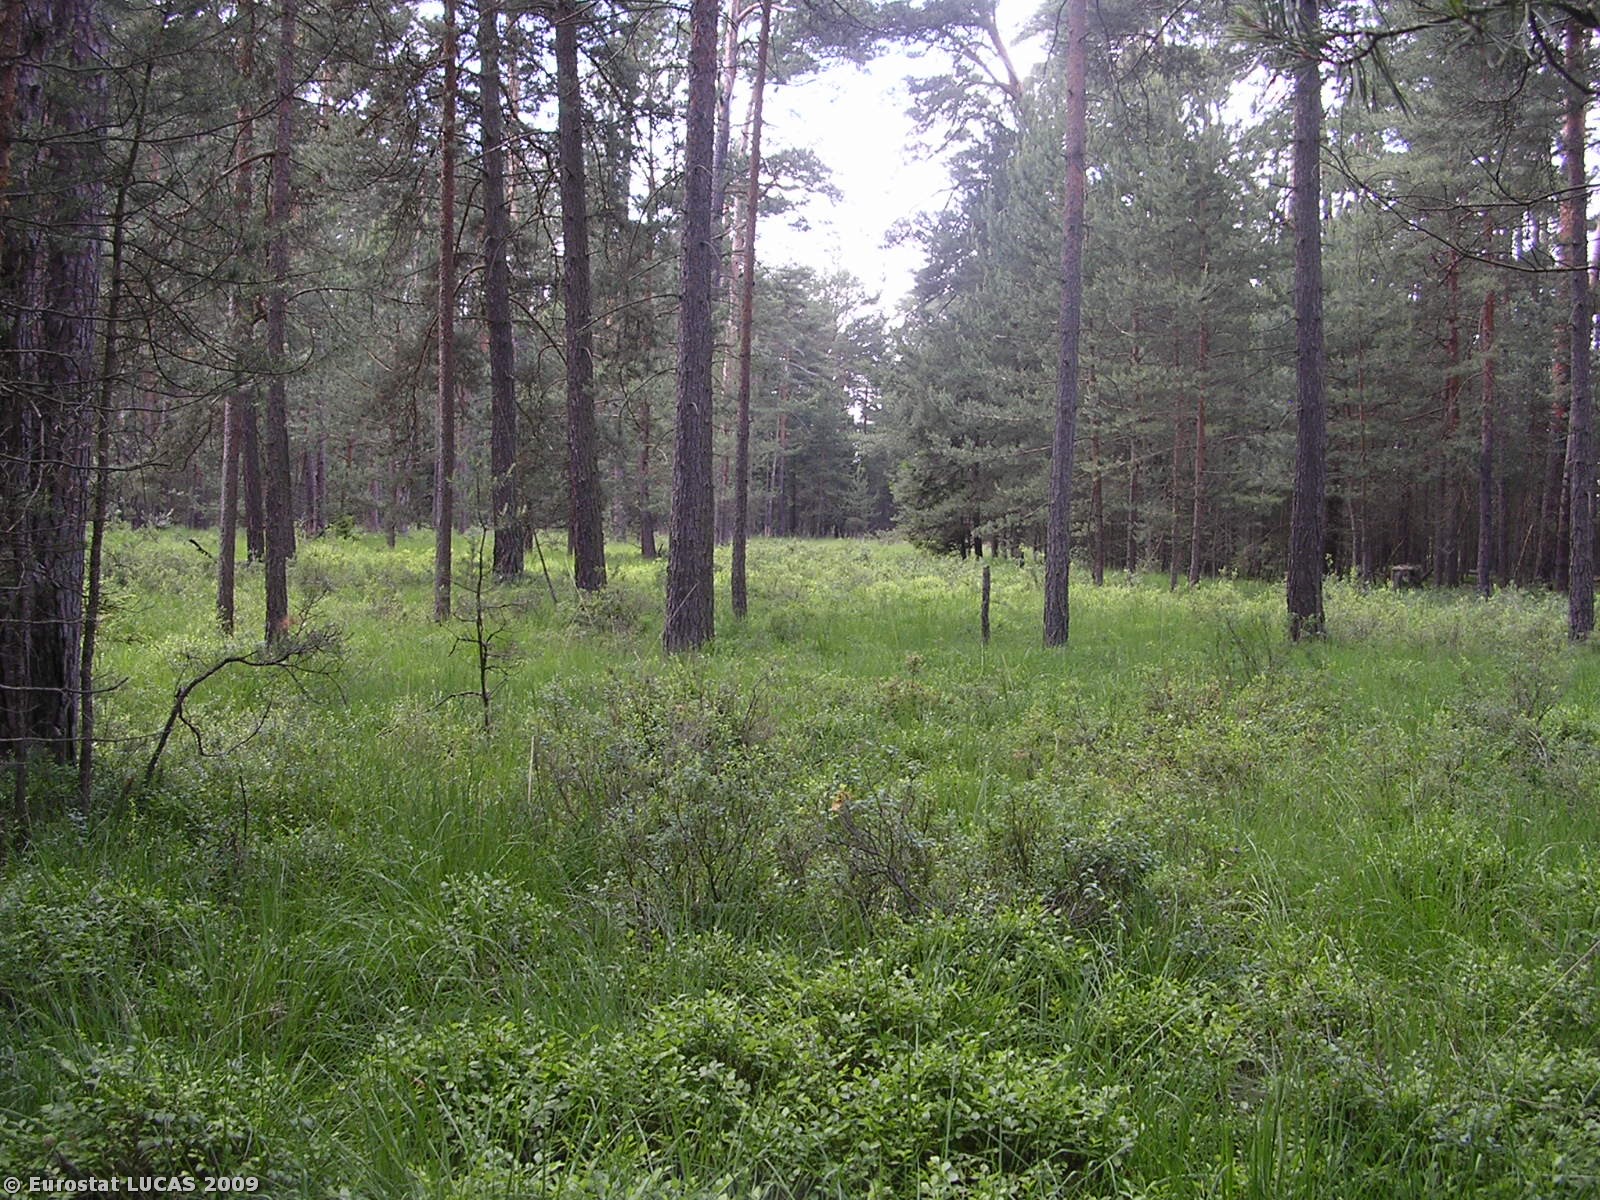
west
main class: Woodland
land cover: Coniferous woodland
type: hemiboreal forest and nemoral coniferous forest and mixed broadleaved-coniferous forest
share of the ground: > 75 %
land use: Nature reserves
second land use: Forestry
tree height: > 5 m
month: June
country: CZ
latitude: 50.5735
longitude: 14.7043
